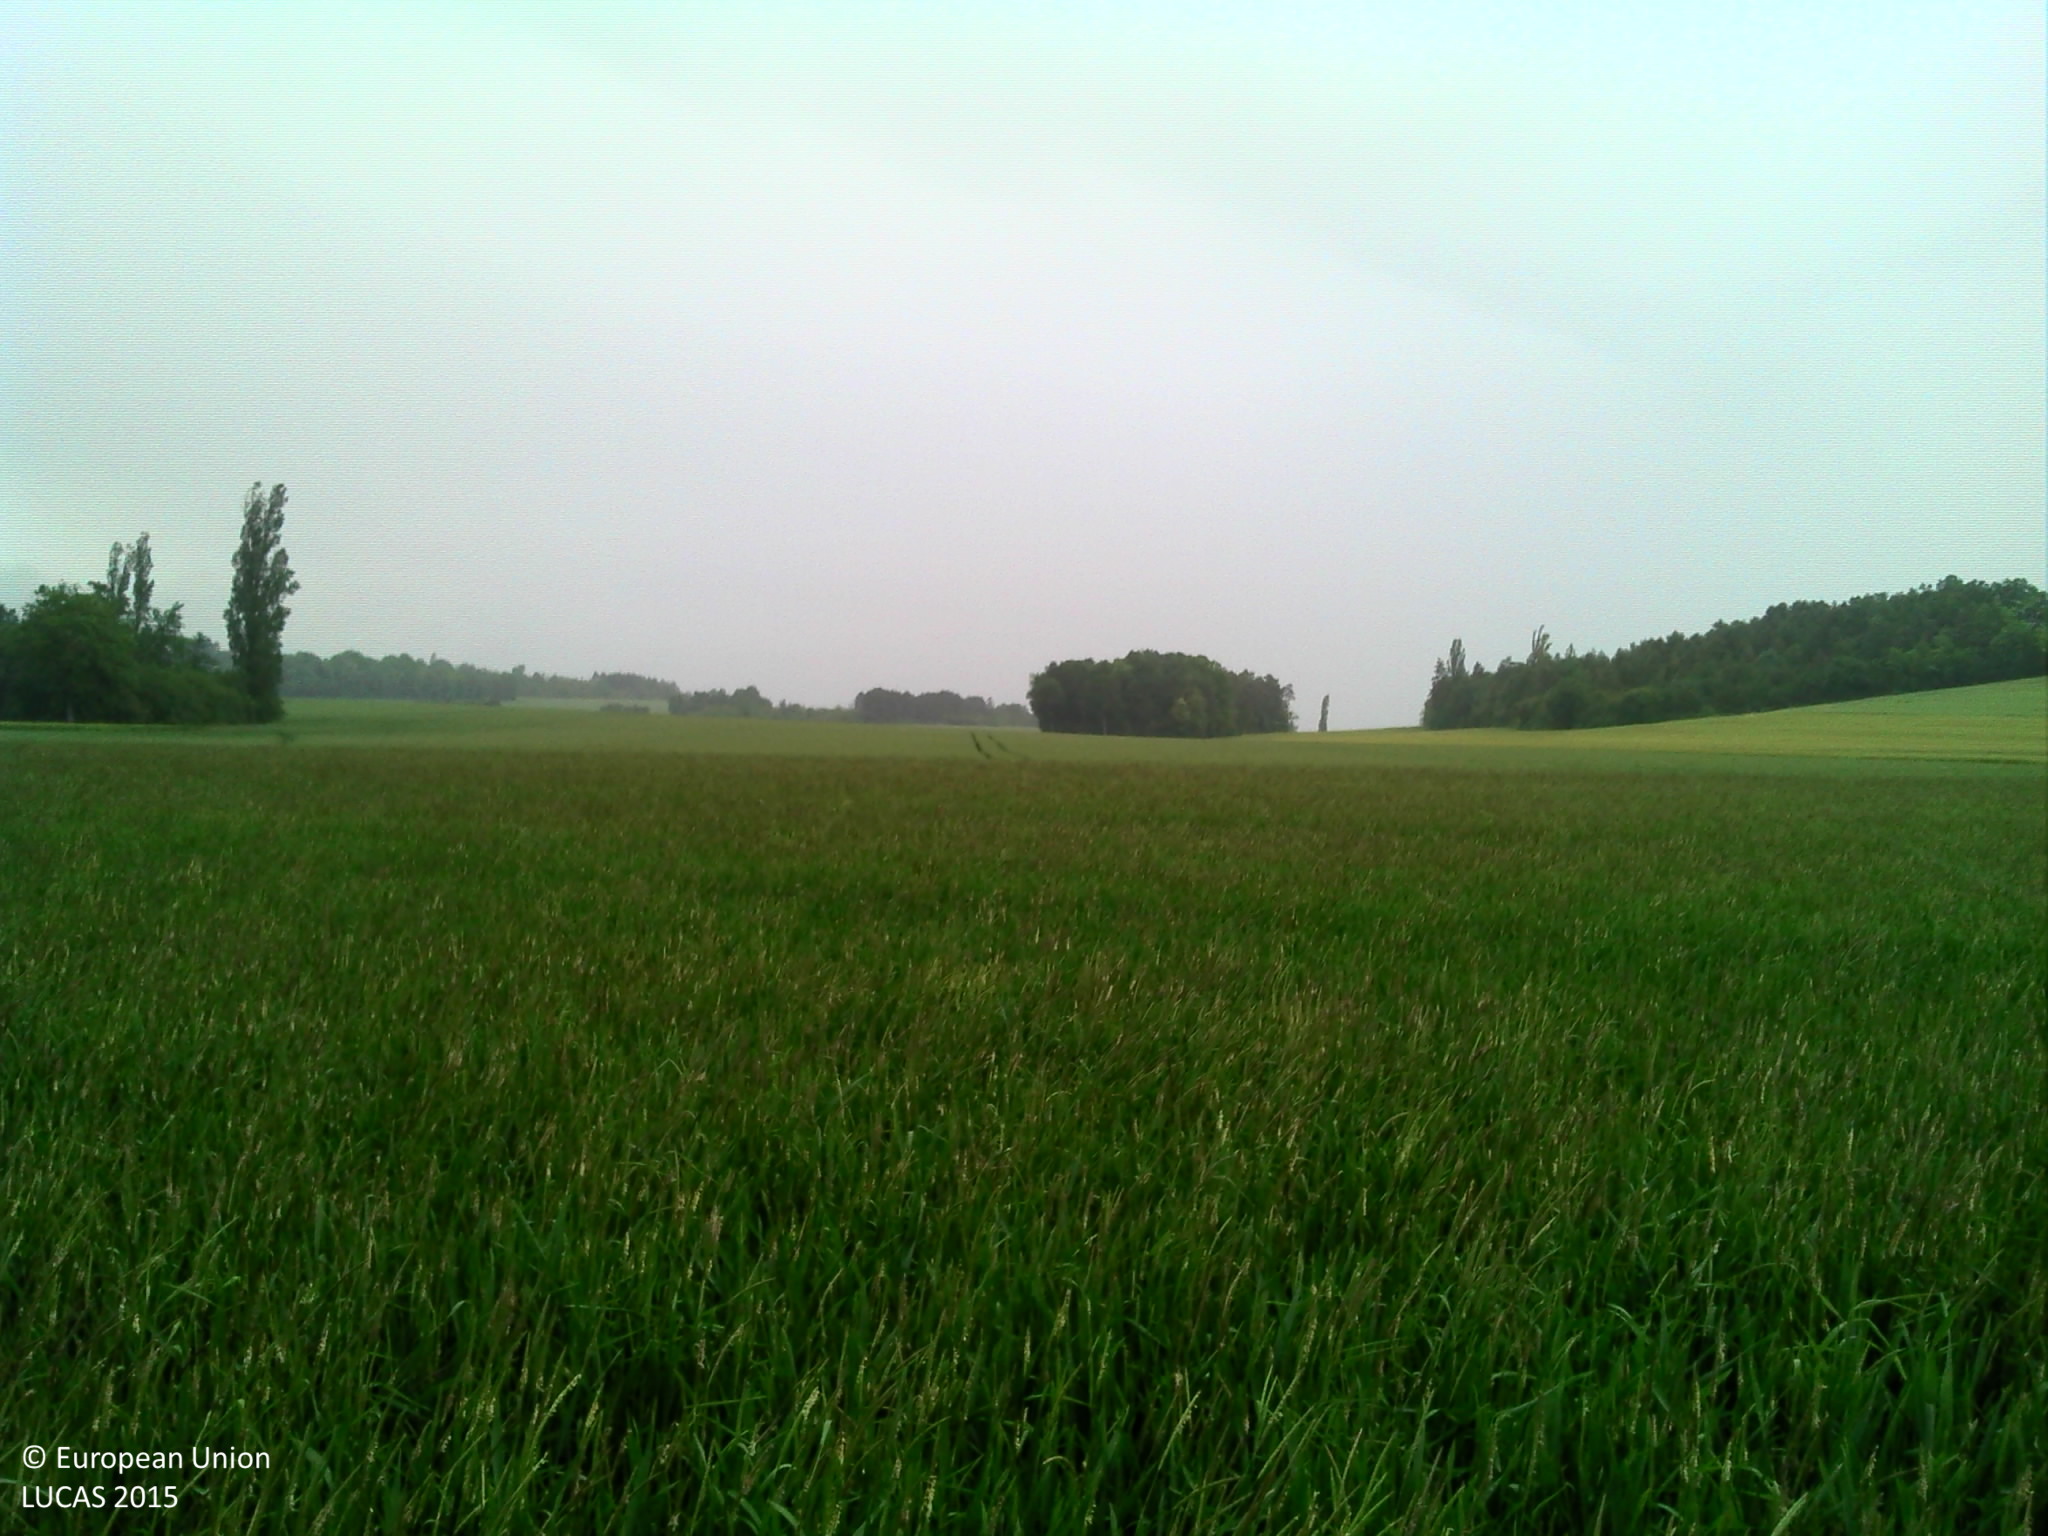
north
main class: Cropland
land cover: Durum wheat
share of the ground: > 75 %
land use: Agriculture (excluding fallow land and kitchen gardens)
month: May
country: FR
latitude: 47.4837
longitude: 5.1032
